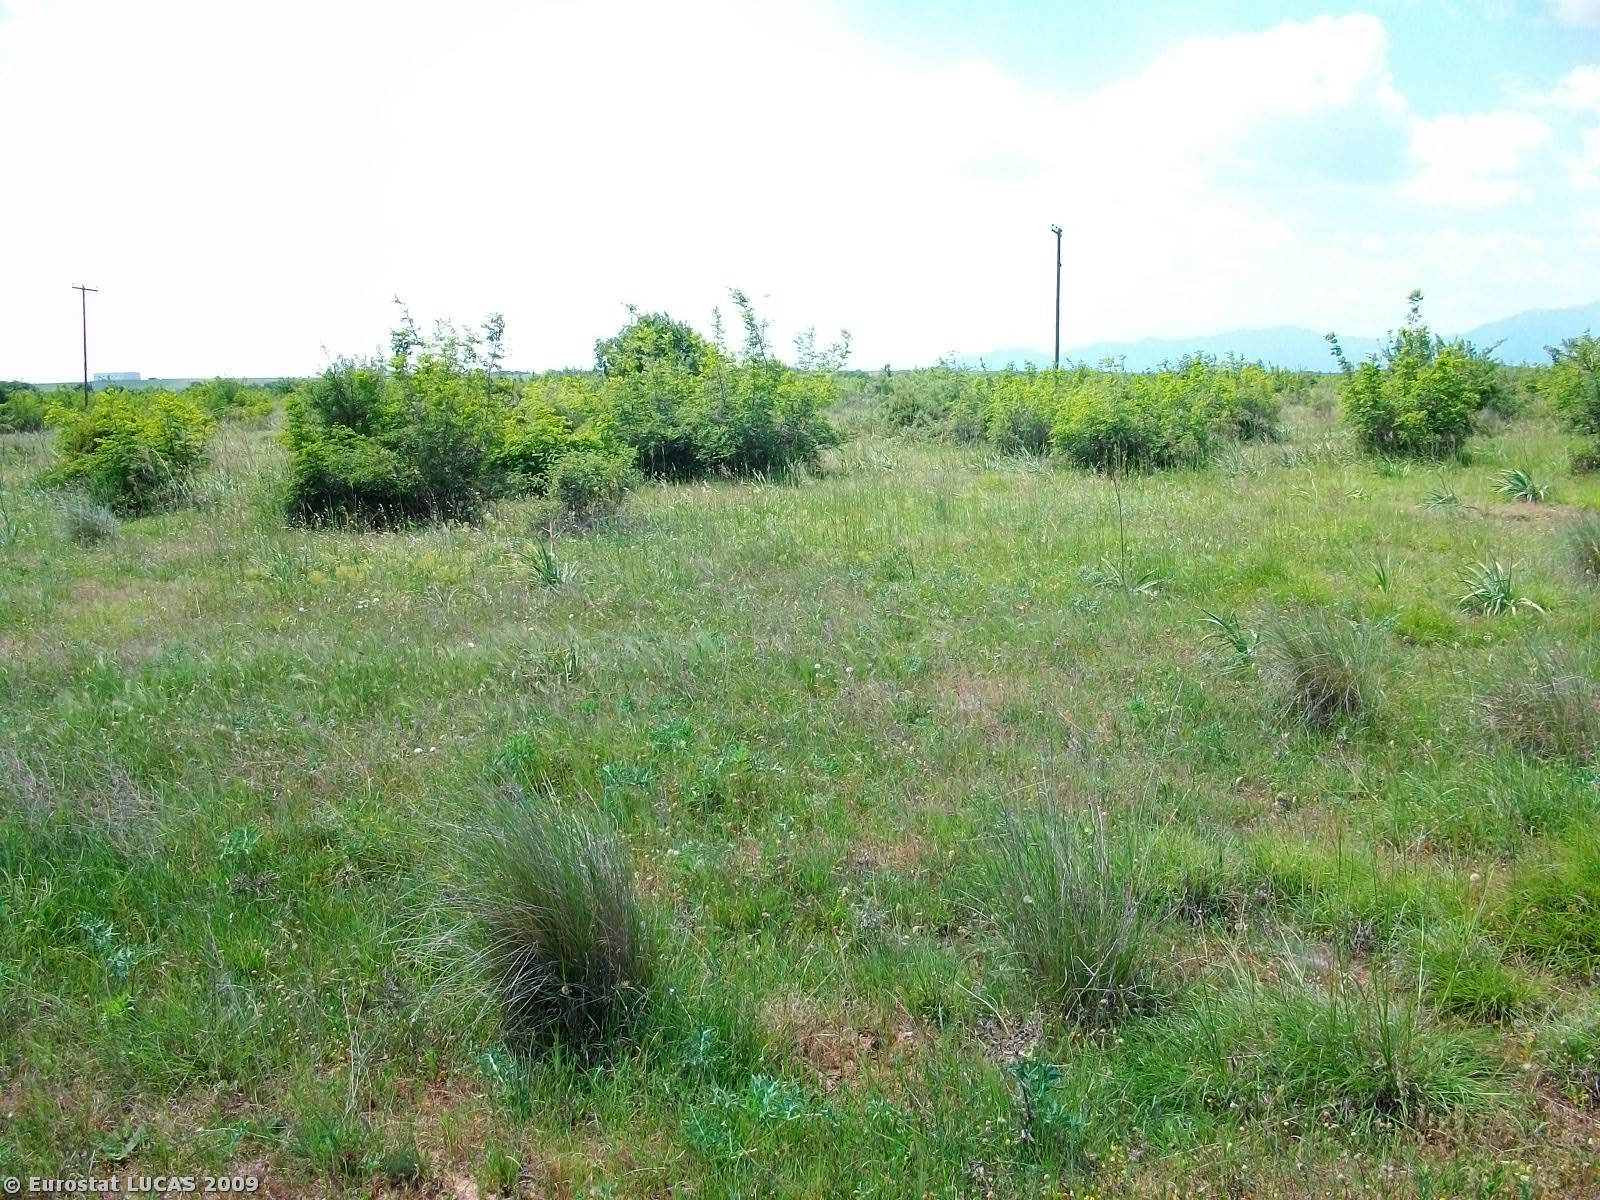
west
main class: Grassland
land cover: Grassland with sparse tree/shrub cover
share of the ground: > 75 %
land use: Unused
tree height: < 5 m
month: May
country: GR
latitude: 41.1005
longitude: 25.5192
